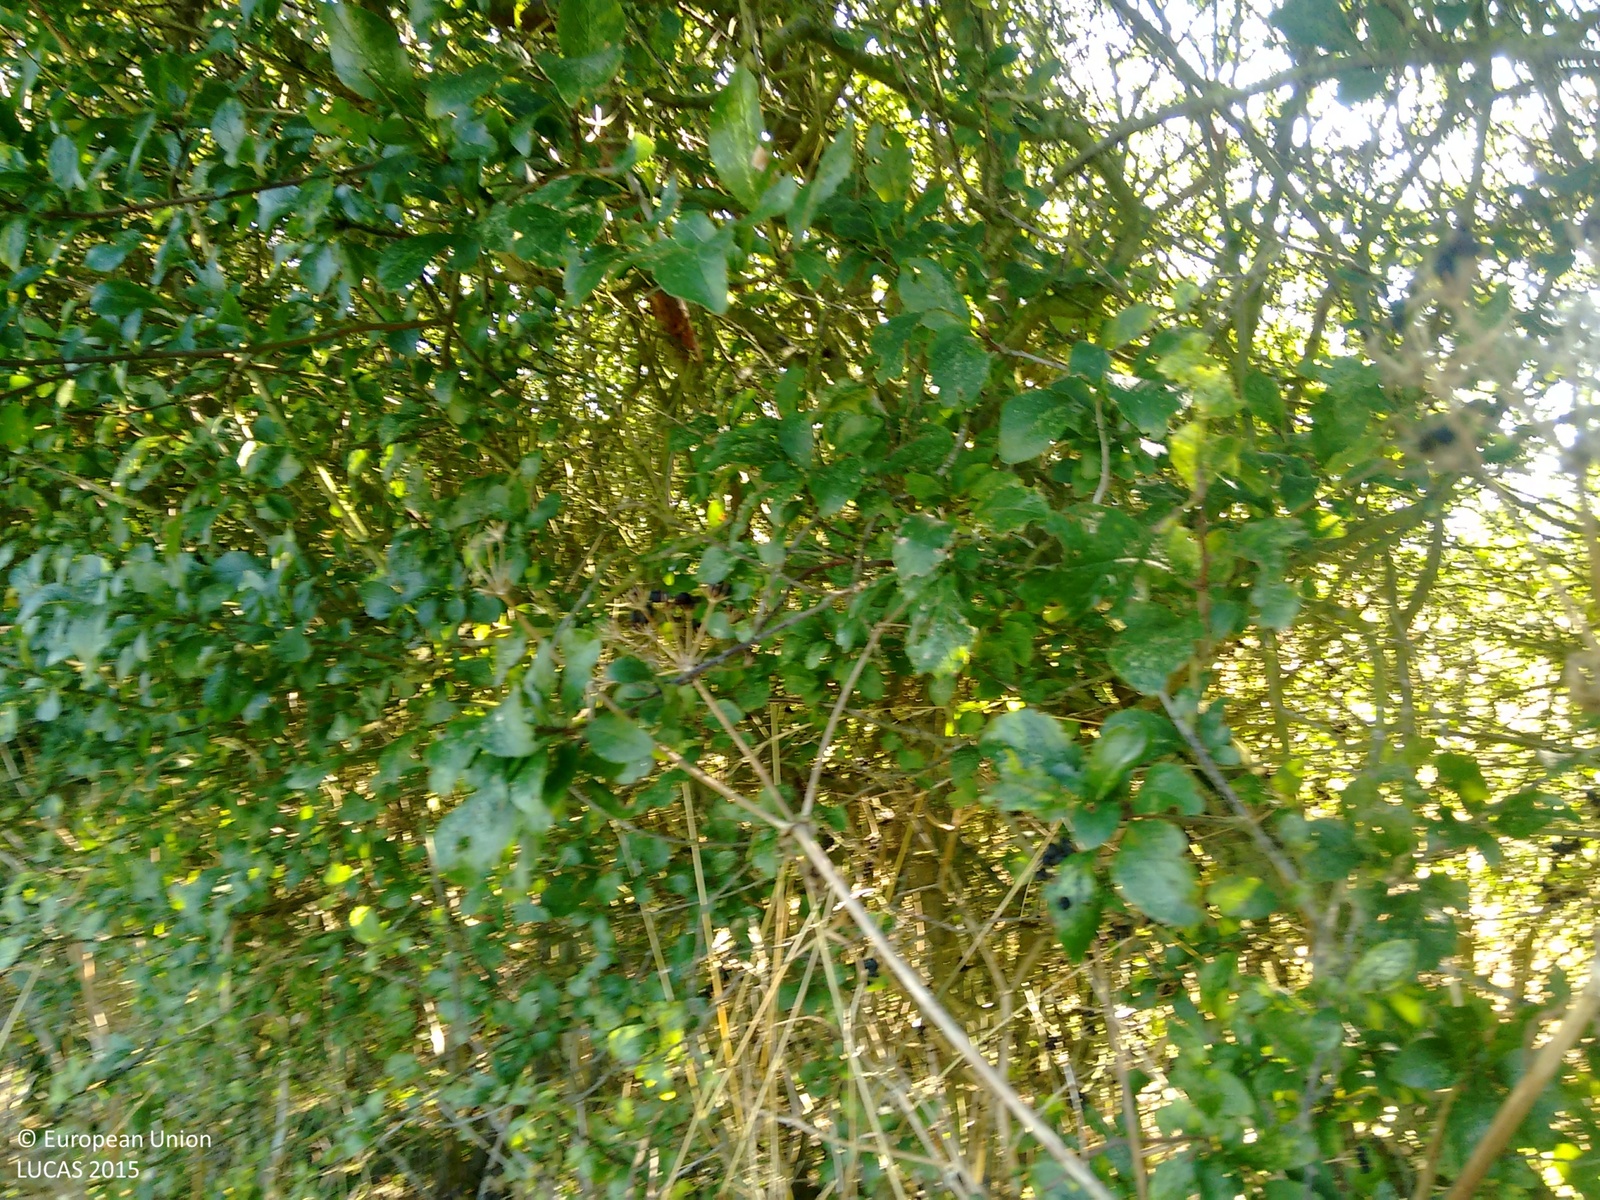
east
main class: Grassland
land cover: Grassland without tree/shrub cover
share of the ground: > 75 %
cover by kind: herbaceous plants 100 %
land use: Agriculture (excluding fallow land and kitchen gardens)
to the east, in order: Grassland without tree/shrub cover; Fences; Managed hedges; Common wheat; Grass margins; Broadleaved woodland; Grass margins; Common wheat
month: September
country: GB
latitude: 52.1753
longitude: 1.4257
